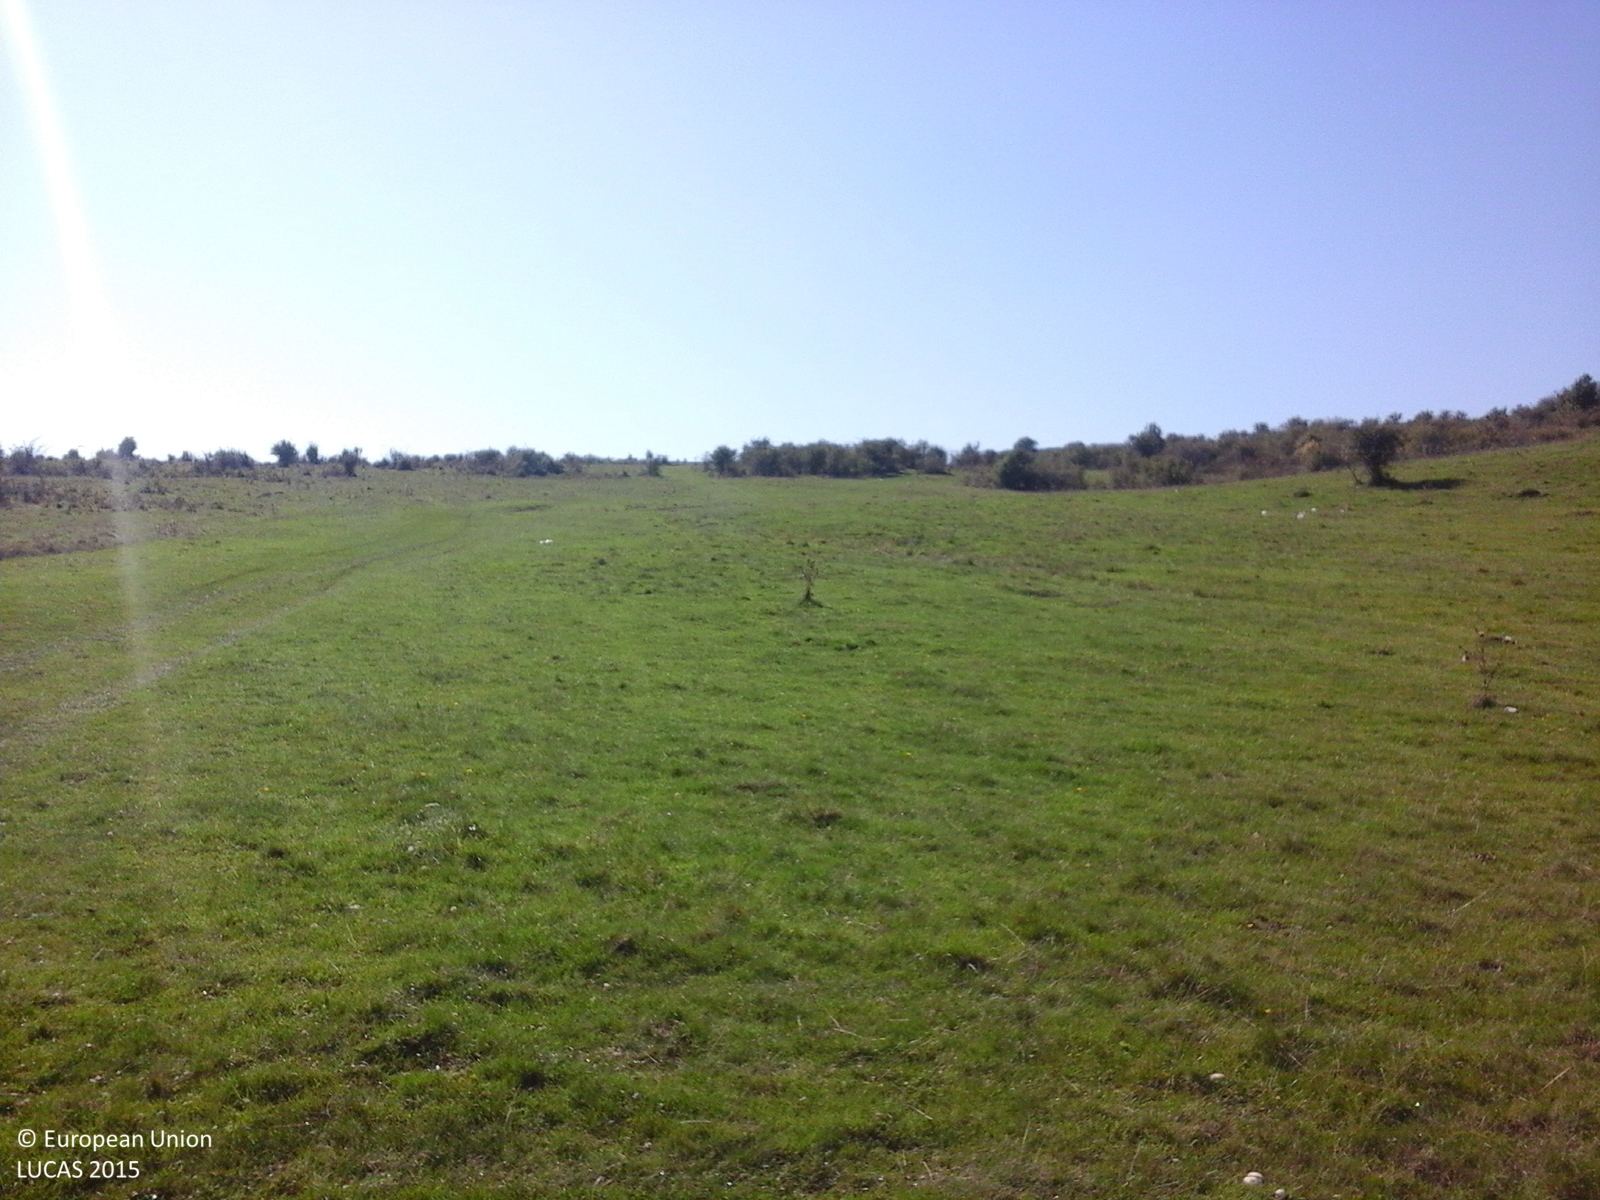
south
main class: Grassland
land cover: Grassland without tree/shrub cover
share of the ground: > 75 %
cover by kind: herbaceous plants 100 %
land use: Agriculture (excluding fallow land and kitchen gardens)
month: October
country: RO
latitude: 46.6115
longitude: 23.5838
